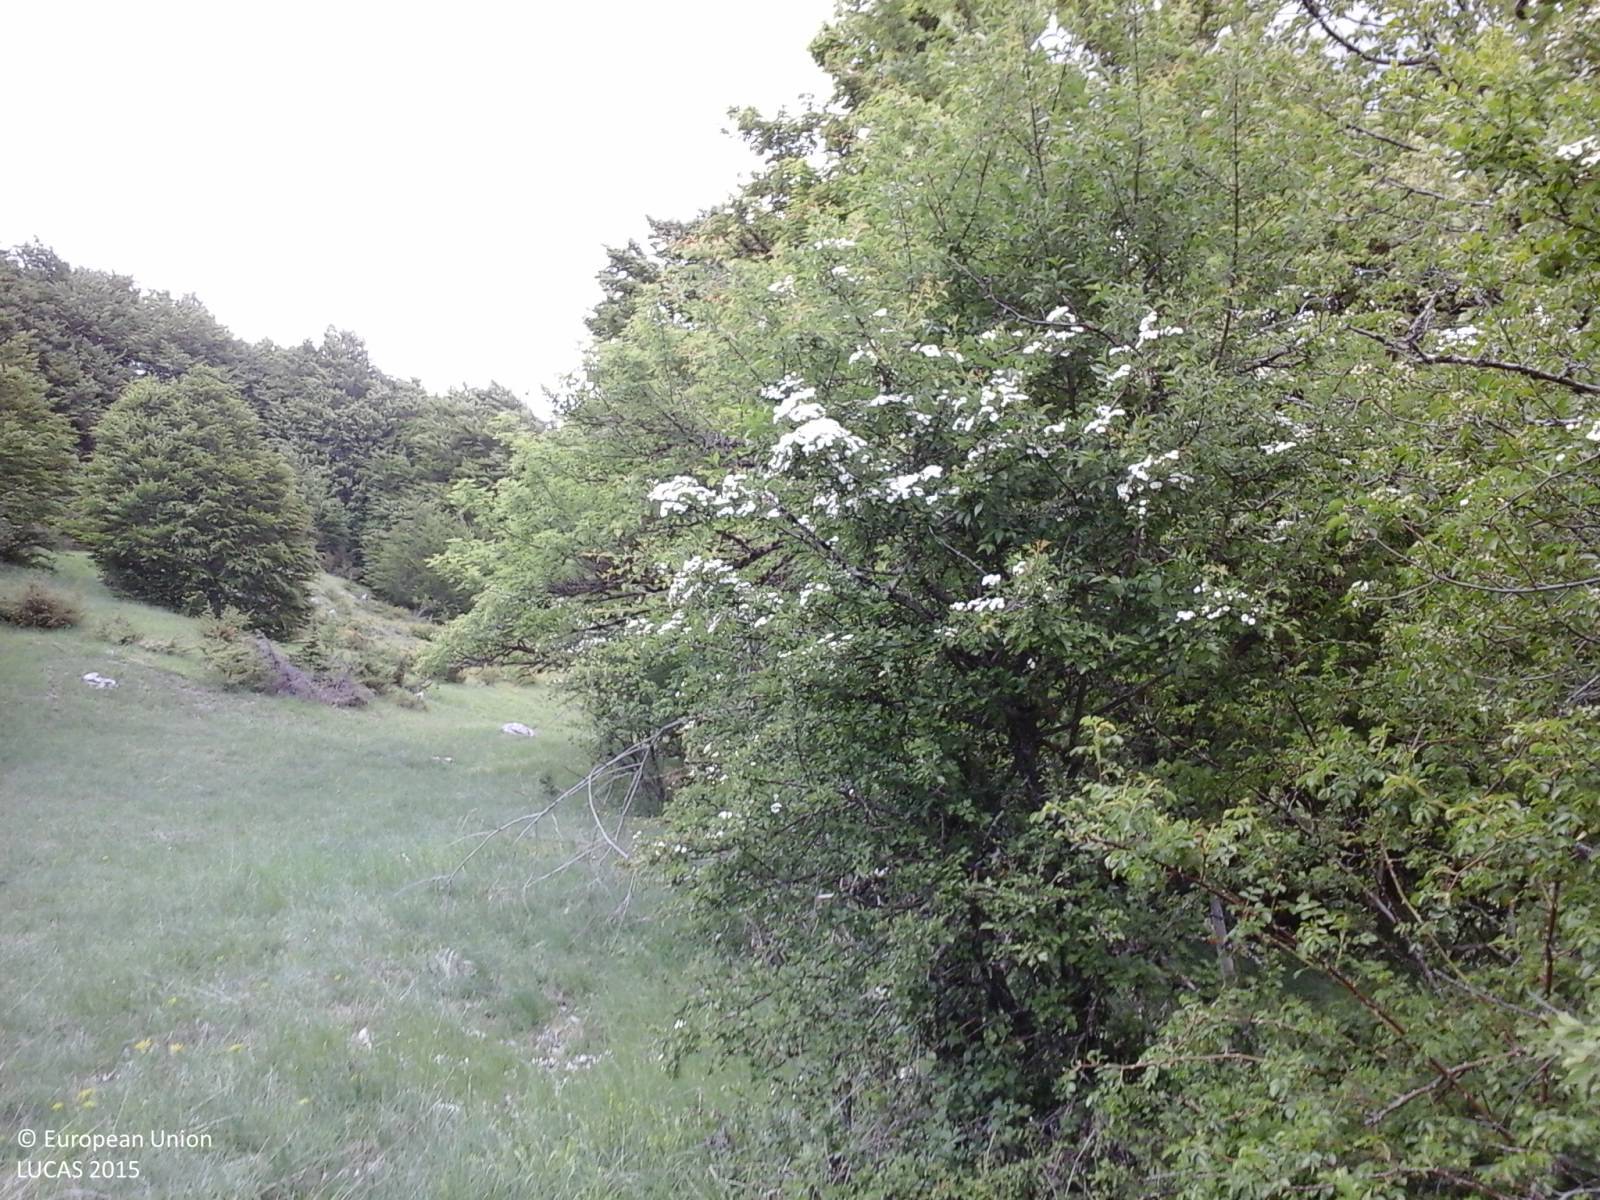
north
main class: Grassland
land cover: Grassland with sparse tree/shrub cover
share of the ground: > 75 %
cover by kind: herbaceous plants 80 %, shrubs 10 %, broadleaved forest trees 5 %, unconsolidated bare surface 5 %
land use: Agriculture (excluding fallow land and kitchen gardens)
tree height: > 5 m
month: May
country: IT
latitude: 41.8420
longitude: 13.7803
